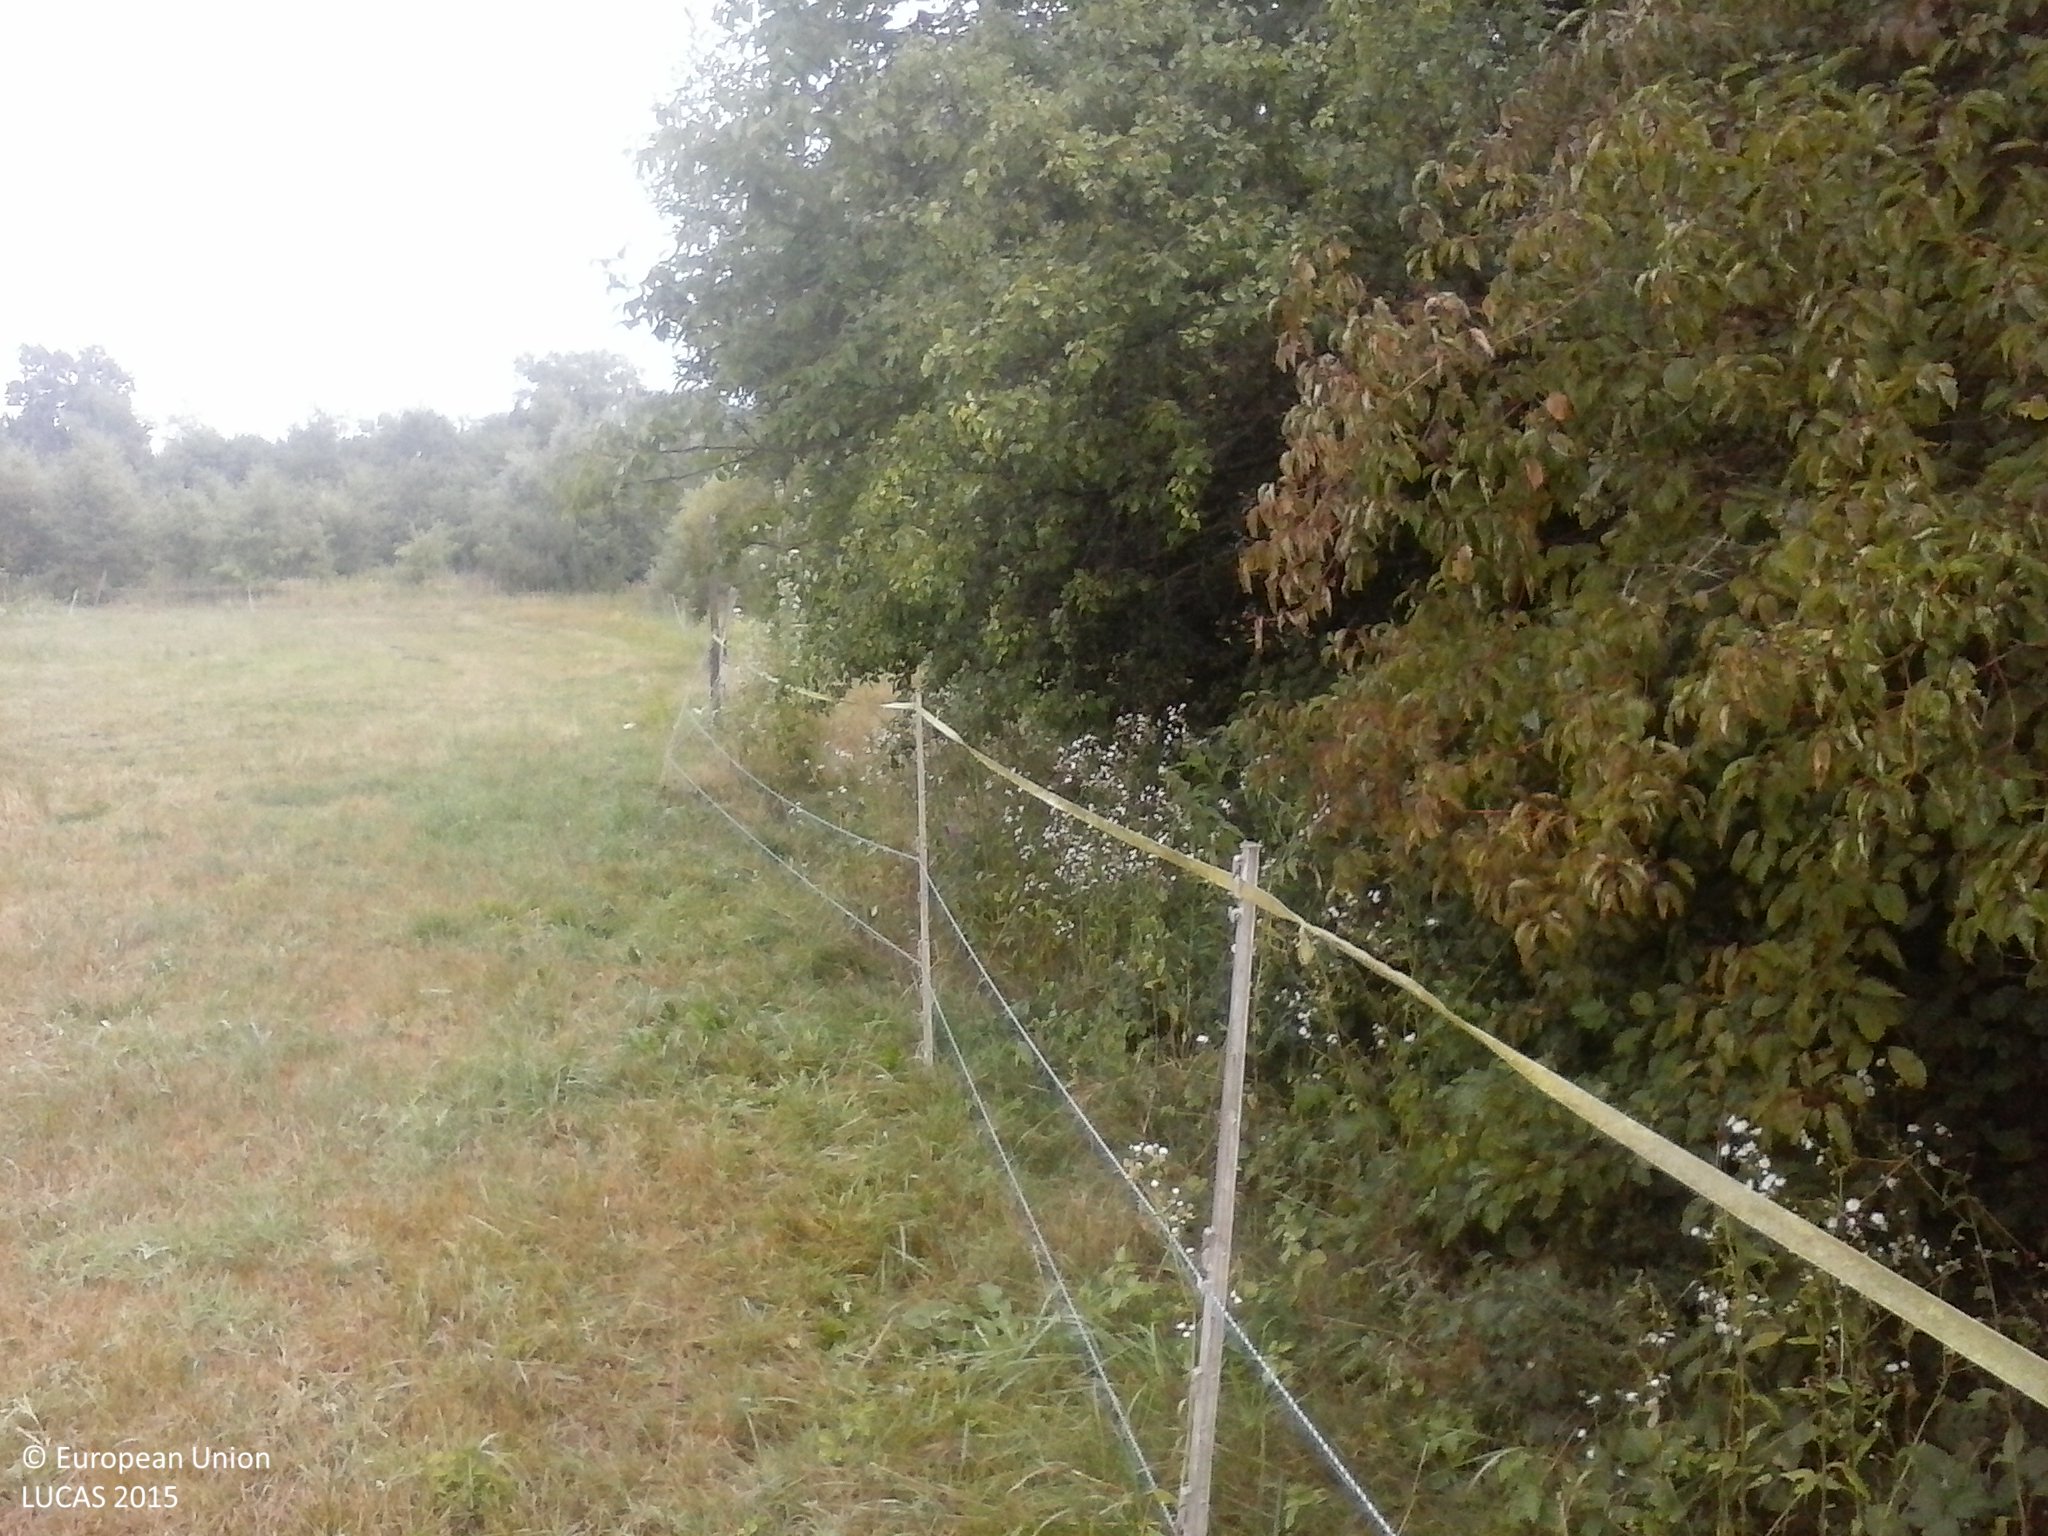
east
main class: Shrubland
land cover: Shrubland with sparse tree cover
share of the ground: > 75 %
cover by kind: shrubs 90 %, broadleaved forest trees 5 %, herbaceous plants 5 %
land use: Agriculture (excluding fallow land and kitchen gardens)
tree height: > 5 m
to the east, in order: Shrubland with sparse tree cover; Grassland without tree/shrub cover; Broadleaved woodland; Inland marshes; Broadleaved woodland; Inland marshes; Inland fresh water bodies; Spontaneously vegetated surfaces; Electric lines; Spontaneously vegetated surfaces
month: July
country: HU
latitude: 46.0359
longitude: 17.7181
